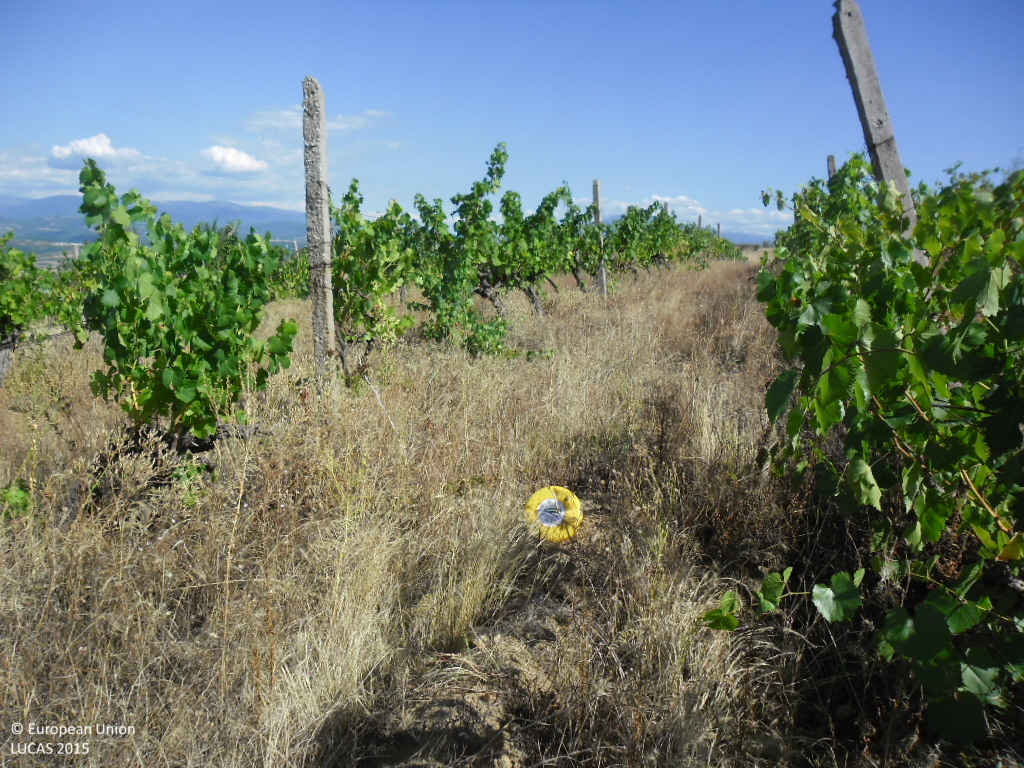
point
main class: Cropland
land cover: Vineyards
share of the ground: 50 - 75 %
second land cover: Spontaneously vegetated surfaces
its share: > 75 %
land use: Agriculture (excluding fallow land and kitchen gardens)
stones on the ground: < 10 %
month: August
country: BG
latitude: 42.0483
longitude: 23.0115
